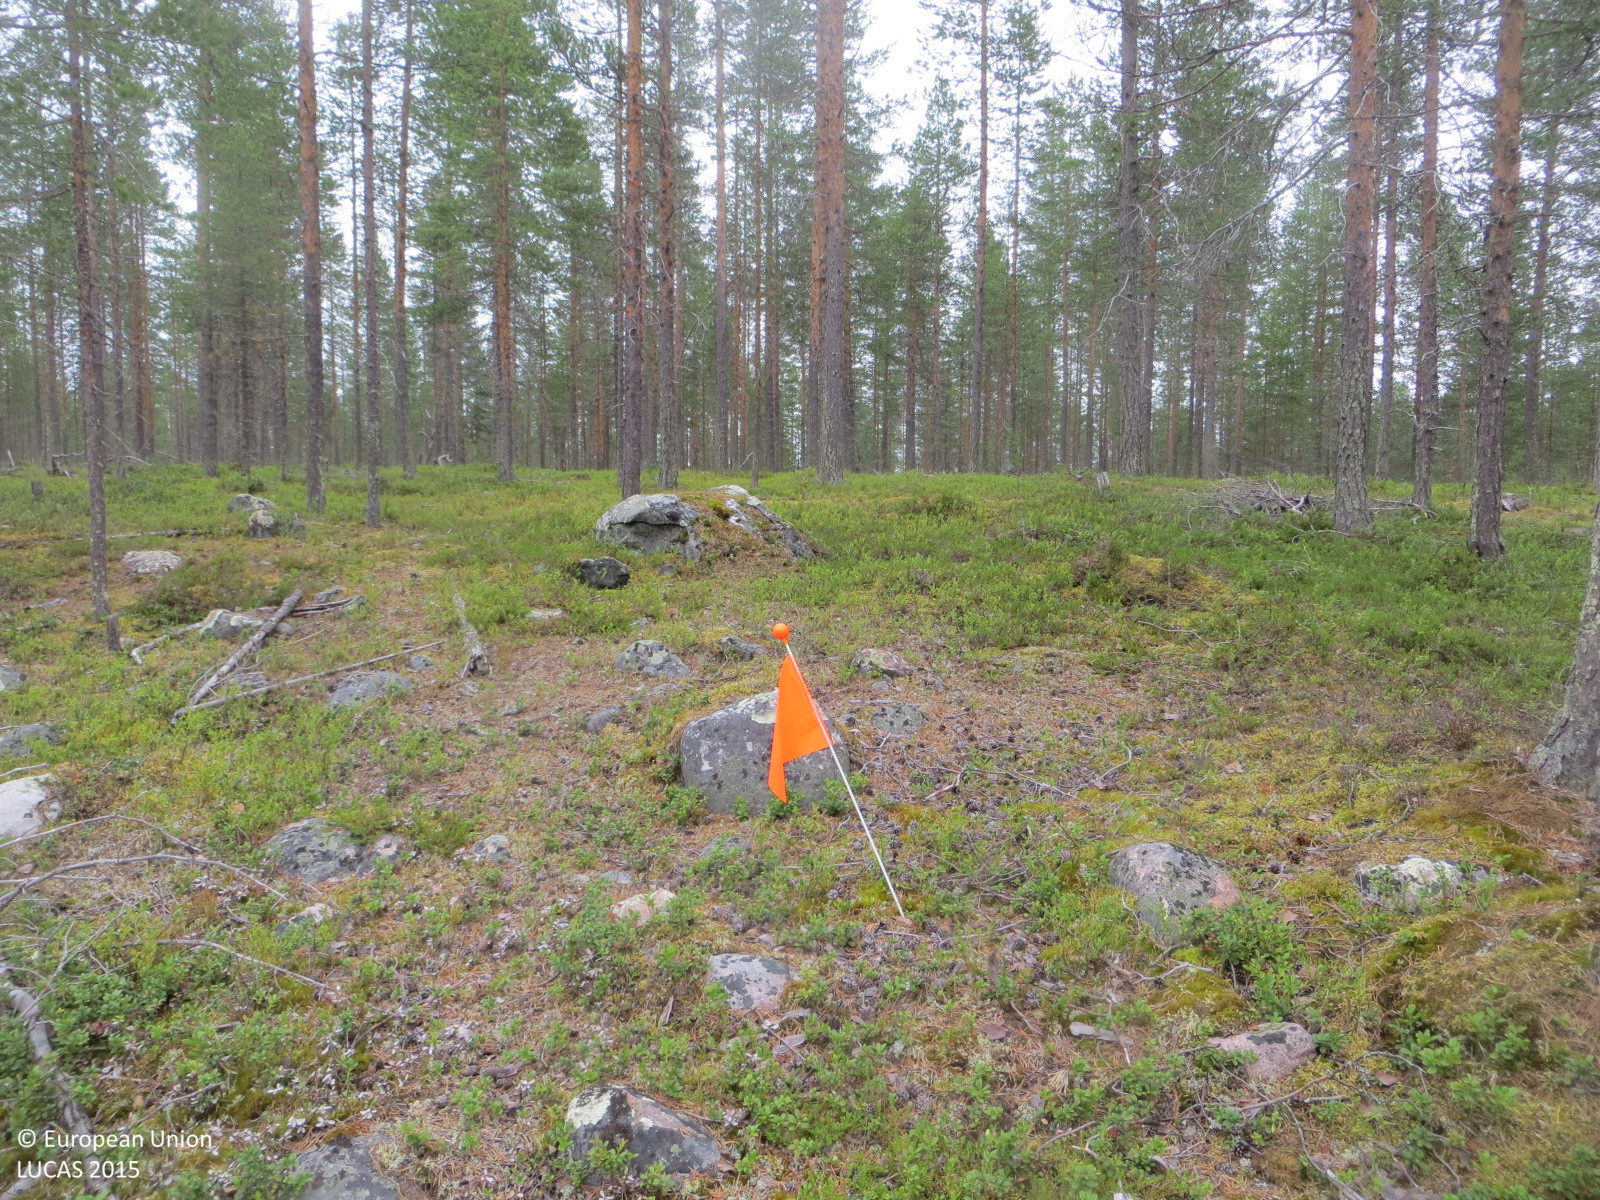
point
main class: Woodland
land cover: Pine dominated coniferous woodland
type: boreal forest
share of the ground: 50 - 75 %
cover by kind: coniferous forest trees 65 %, shrubs 35 %
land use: Forestry
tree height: > 5 m
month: July
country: FI
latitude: 66.4657
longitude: 24.2017
